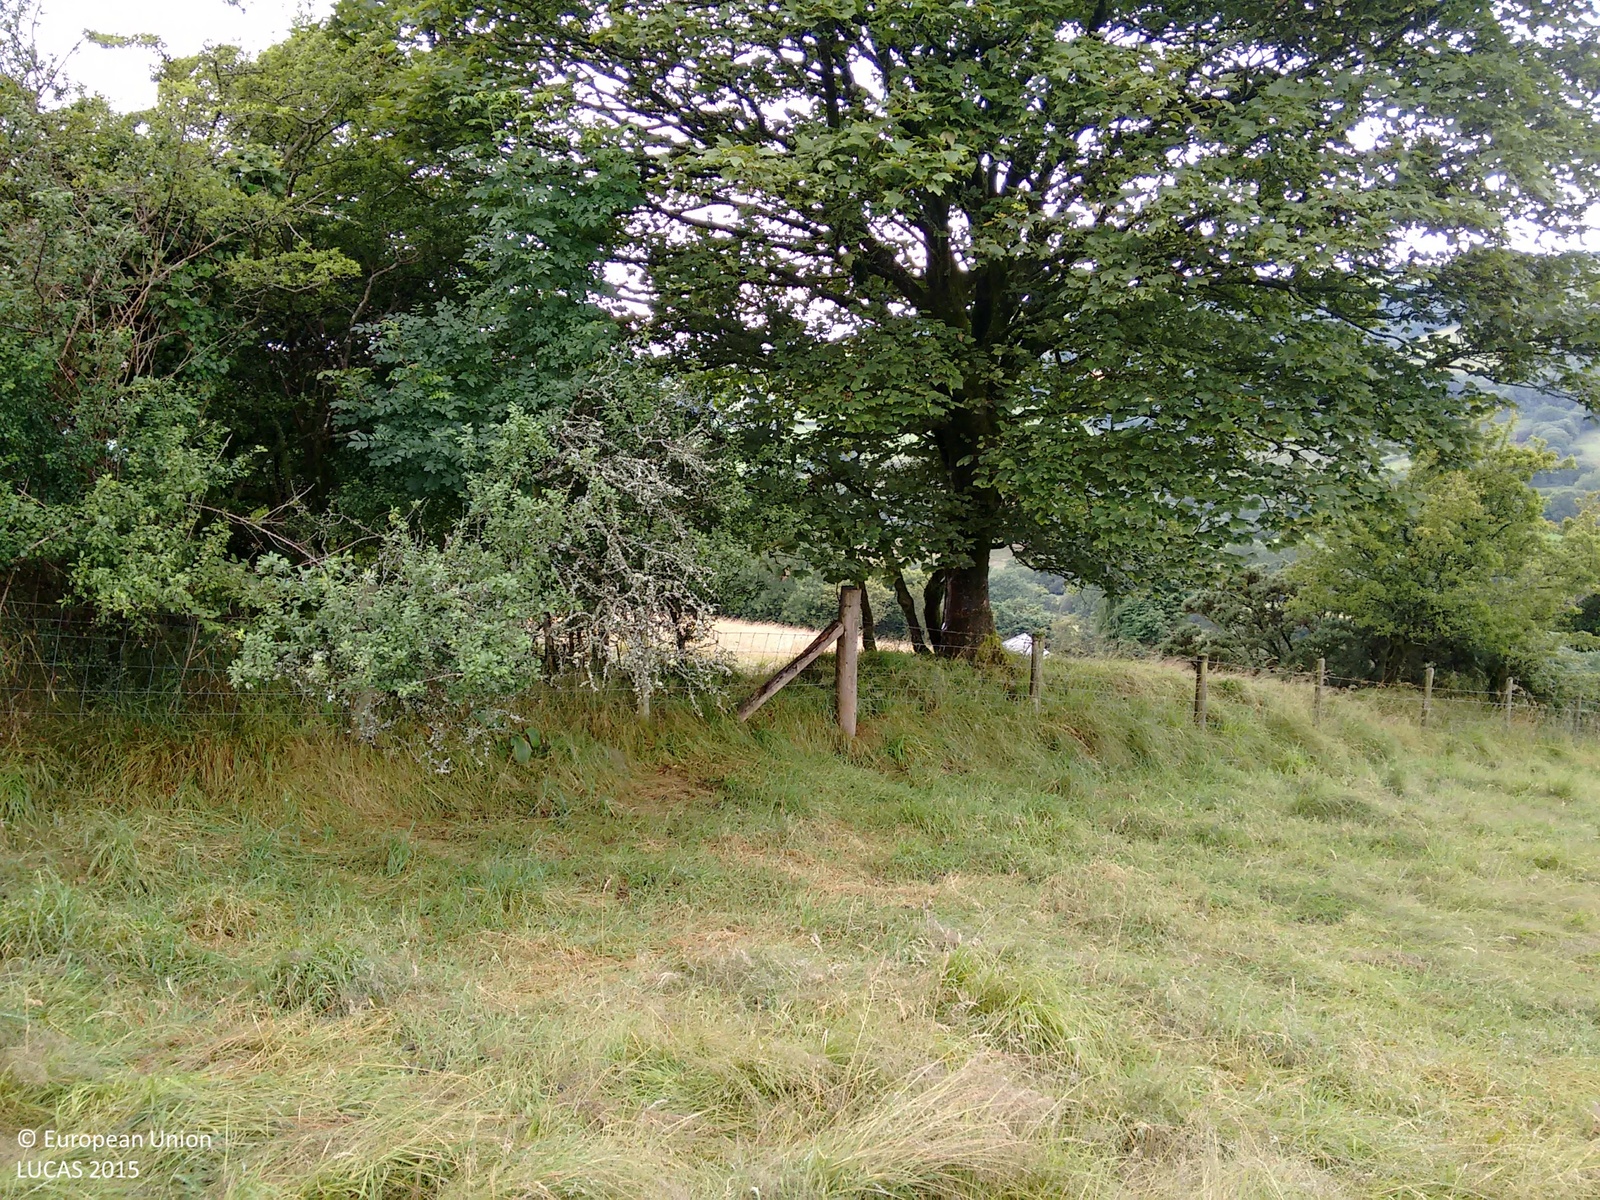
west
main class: Grassland
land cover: Grassland without tree/shrub cover
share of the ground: > 75 %
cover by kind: herbaceous plants 100 %
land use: Agriculture (excluding fallow land and kitchen gardens)
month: August
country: GB
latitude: 51.9386
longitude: -4.0451
